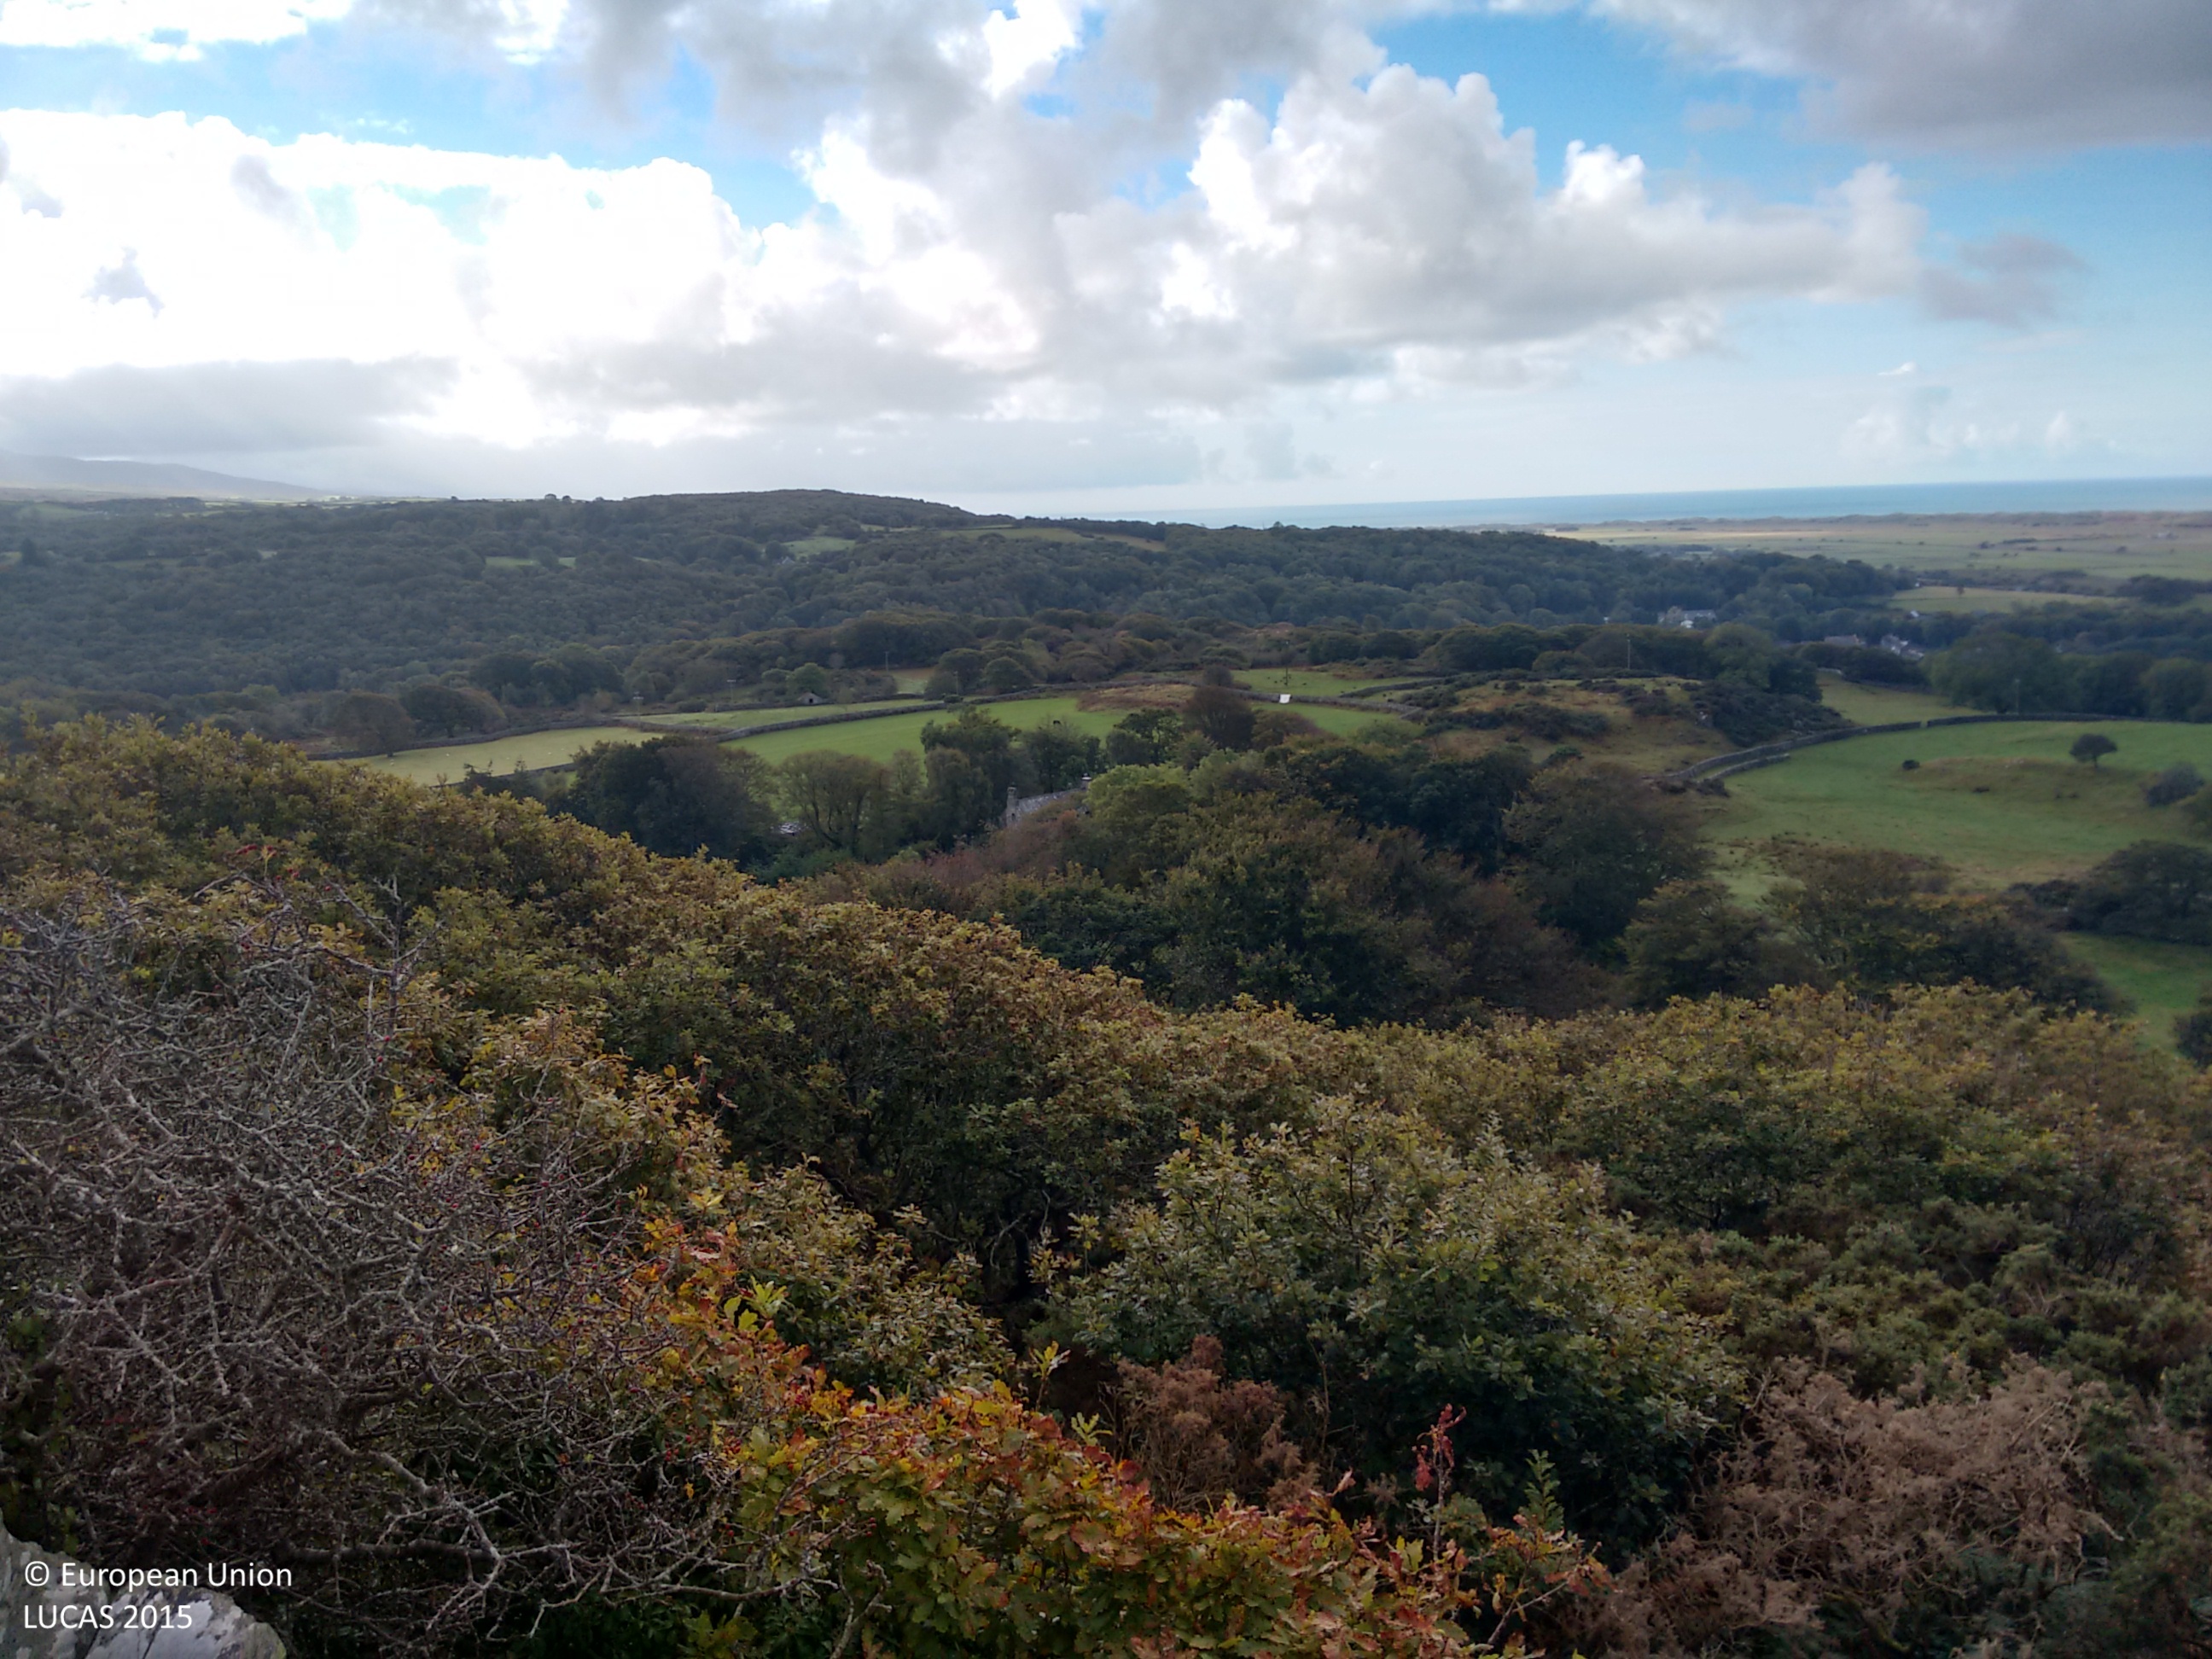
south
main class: Woodland
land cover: Broadleaved woodland
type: mesophytic deciduous forest
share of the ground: > 75 %
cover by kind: broadleaved forest trees 100 %
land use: Semi-natural and natural areas not in use
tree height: > 5 m
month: October
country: GB
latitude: 52.8279
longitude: -4.0919
